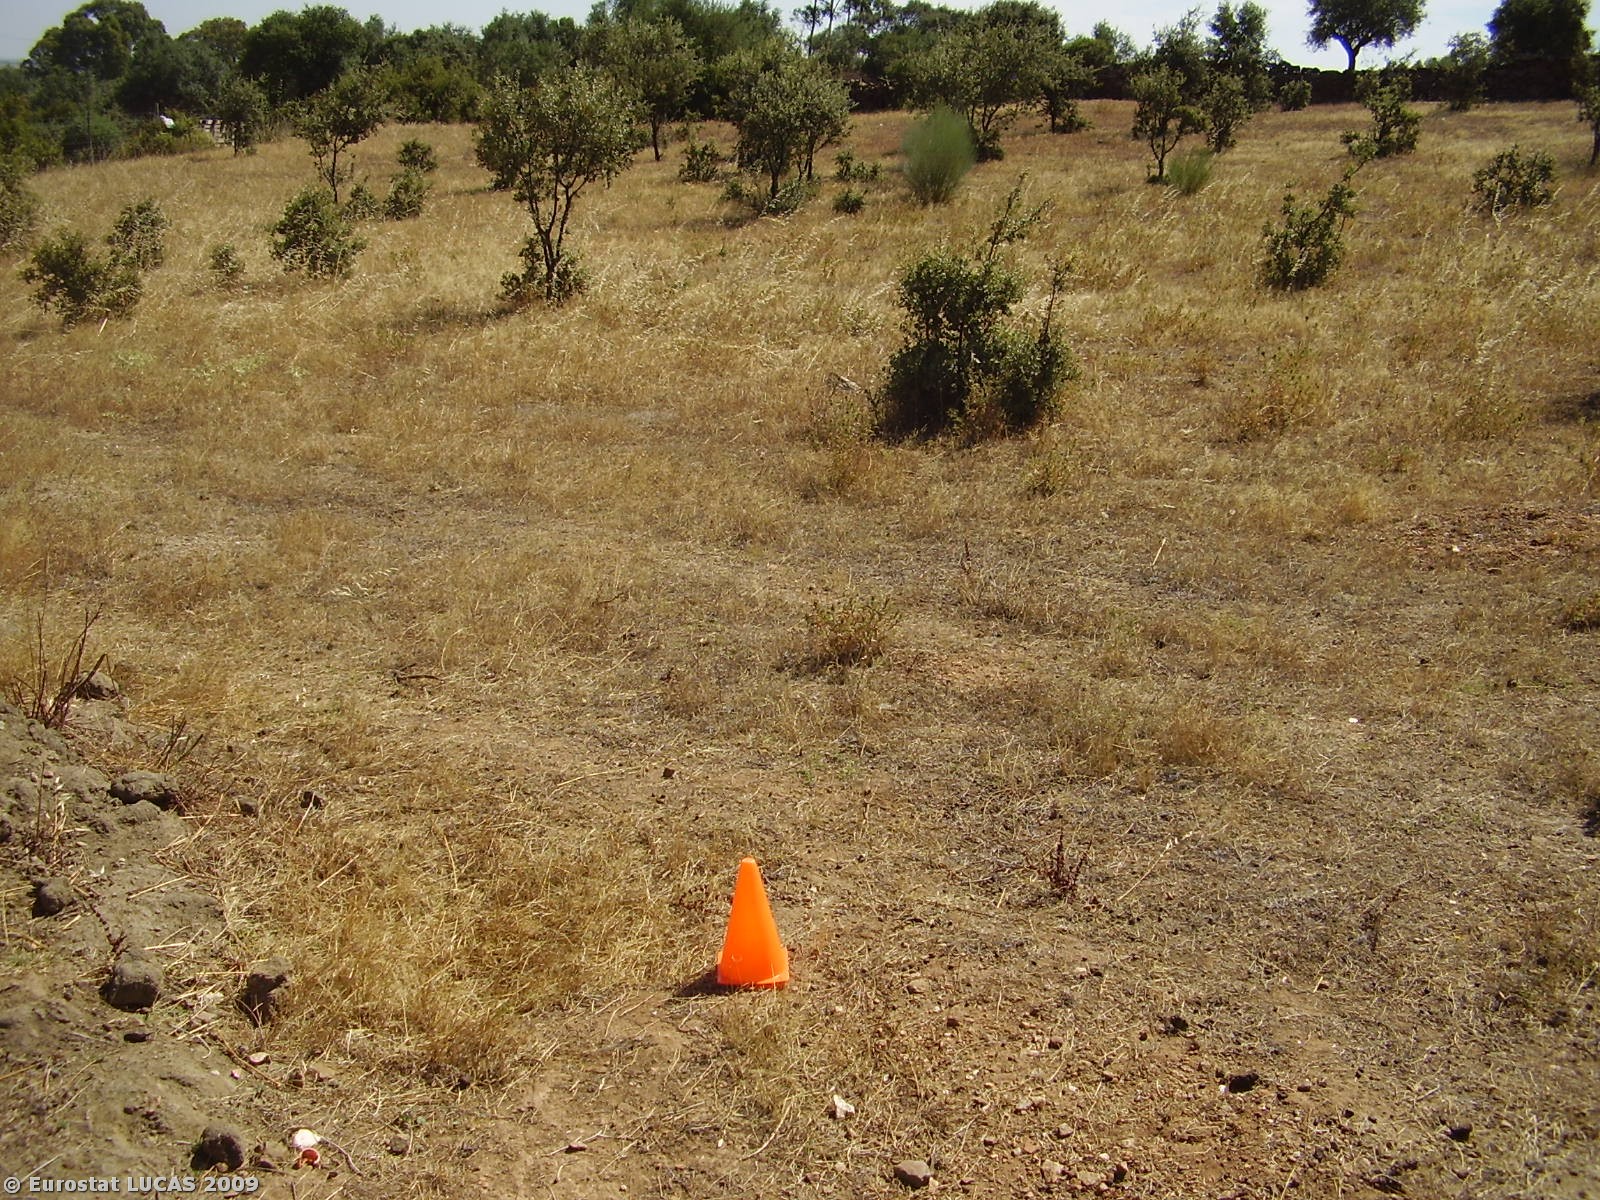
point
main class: Woodland
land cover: Broadleaved woodland
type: broadleaved evergreen forest
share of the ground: 10 - 25 %
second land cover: Grassland with sparse tree/shrub cover
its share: 50 - 75 %
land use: Forestry
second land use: Fallow land
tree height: > 5 m
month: July
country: PT
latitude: 38.7211
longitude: -7.9751
